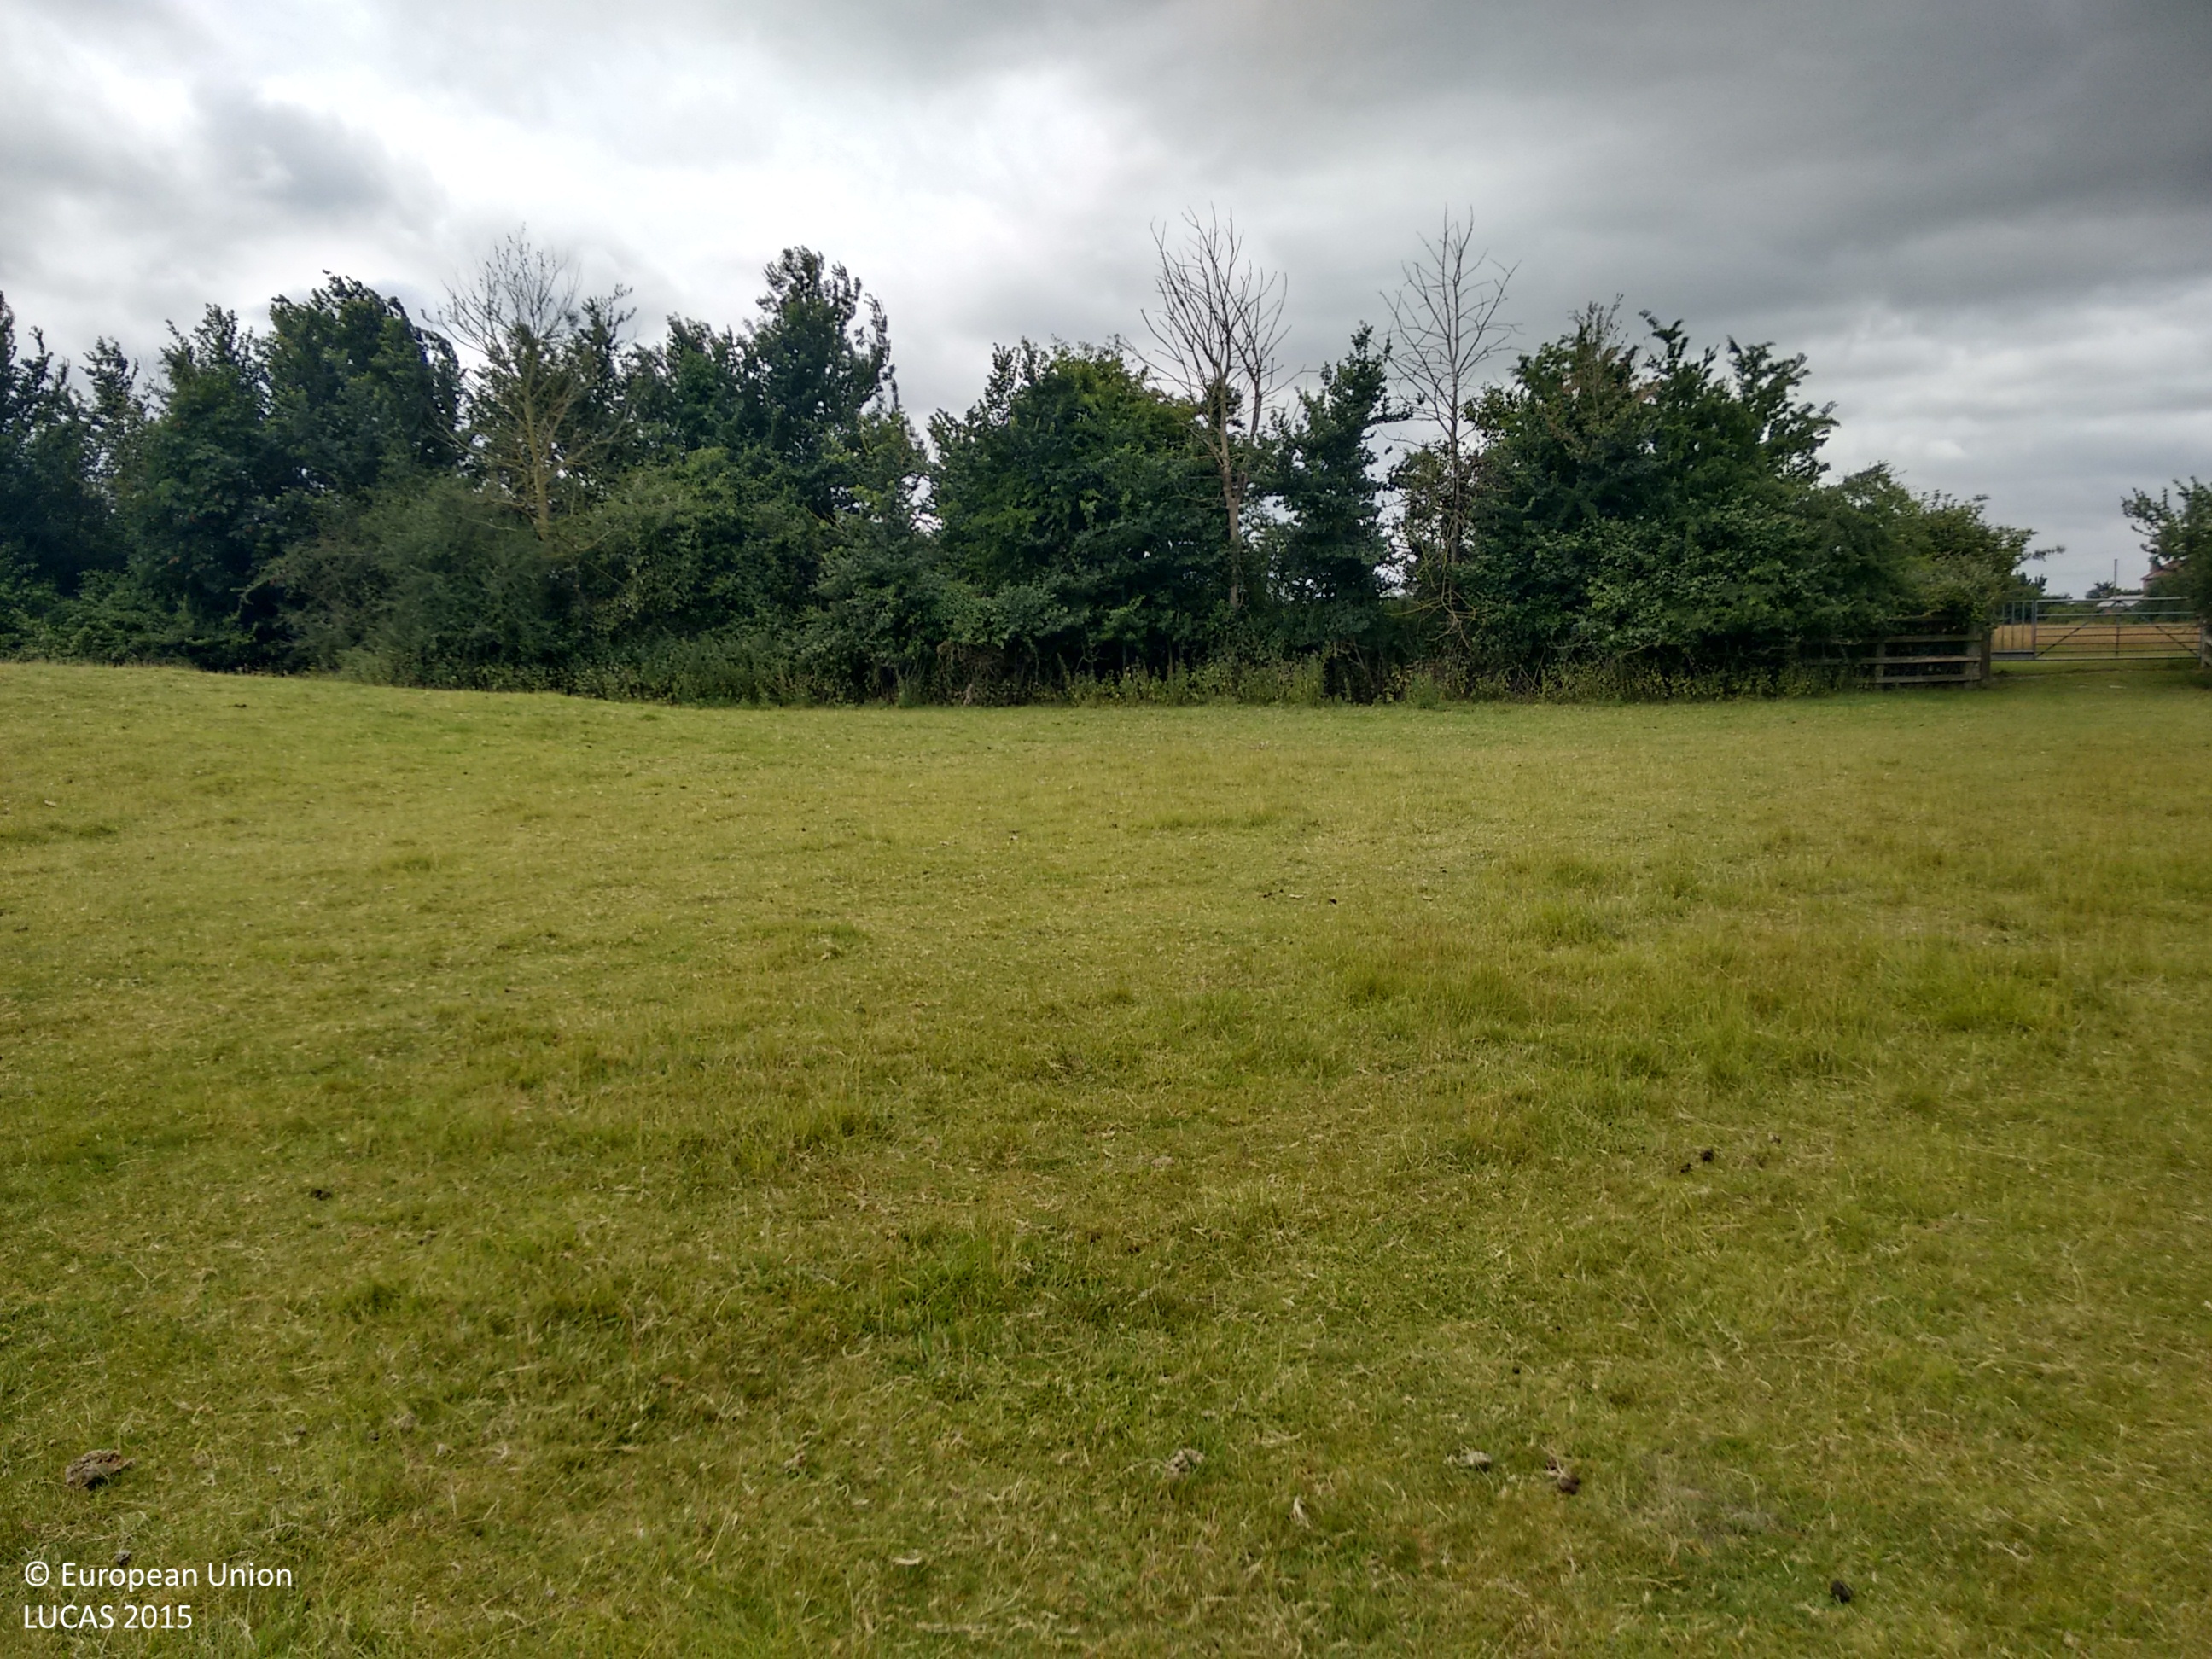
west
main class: Grassland
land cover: Grassland without tree/shrub cover
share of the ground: > 75 %
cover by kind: herbaceous plants 100 %
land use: Agriculture (excluding fallow land and kitchen gardens)
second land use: Amenities, museums, leisure
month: July
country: GB
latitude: 51.1535
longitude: -2.9558
